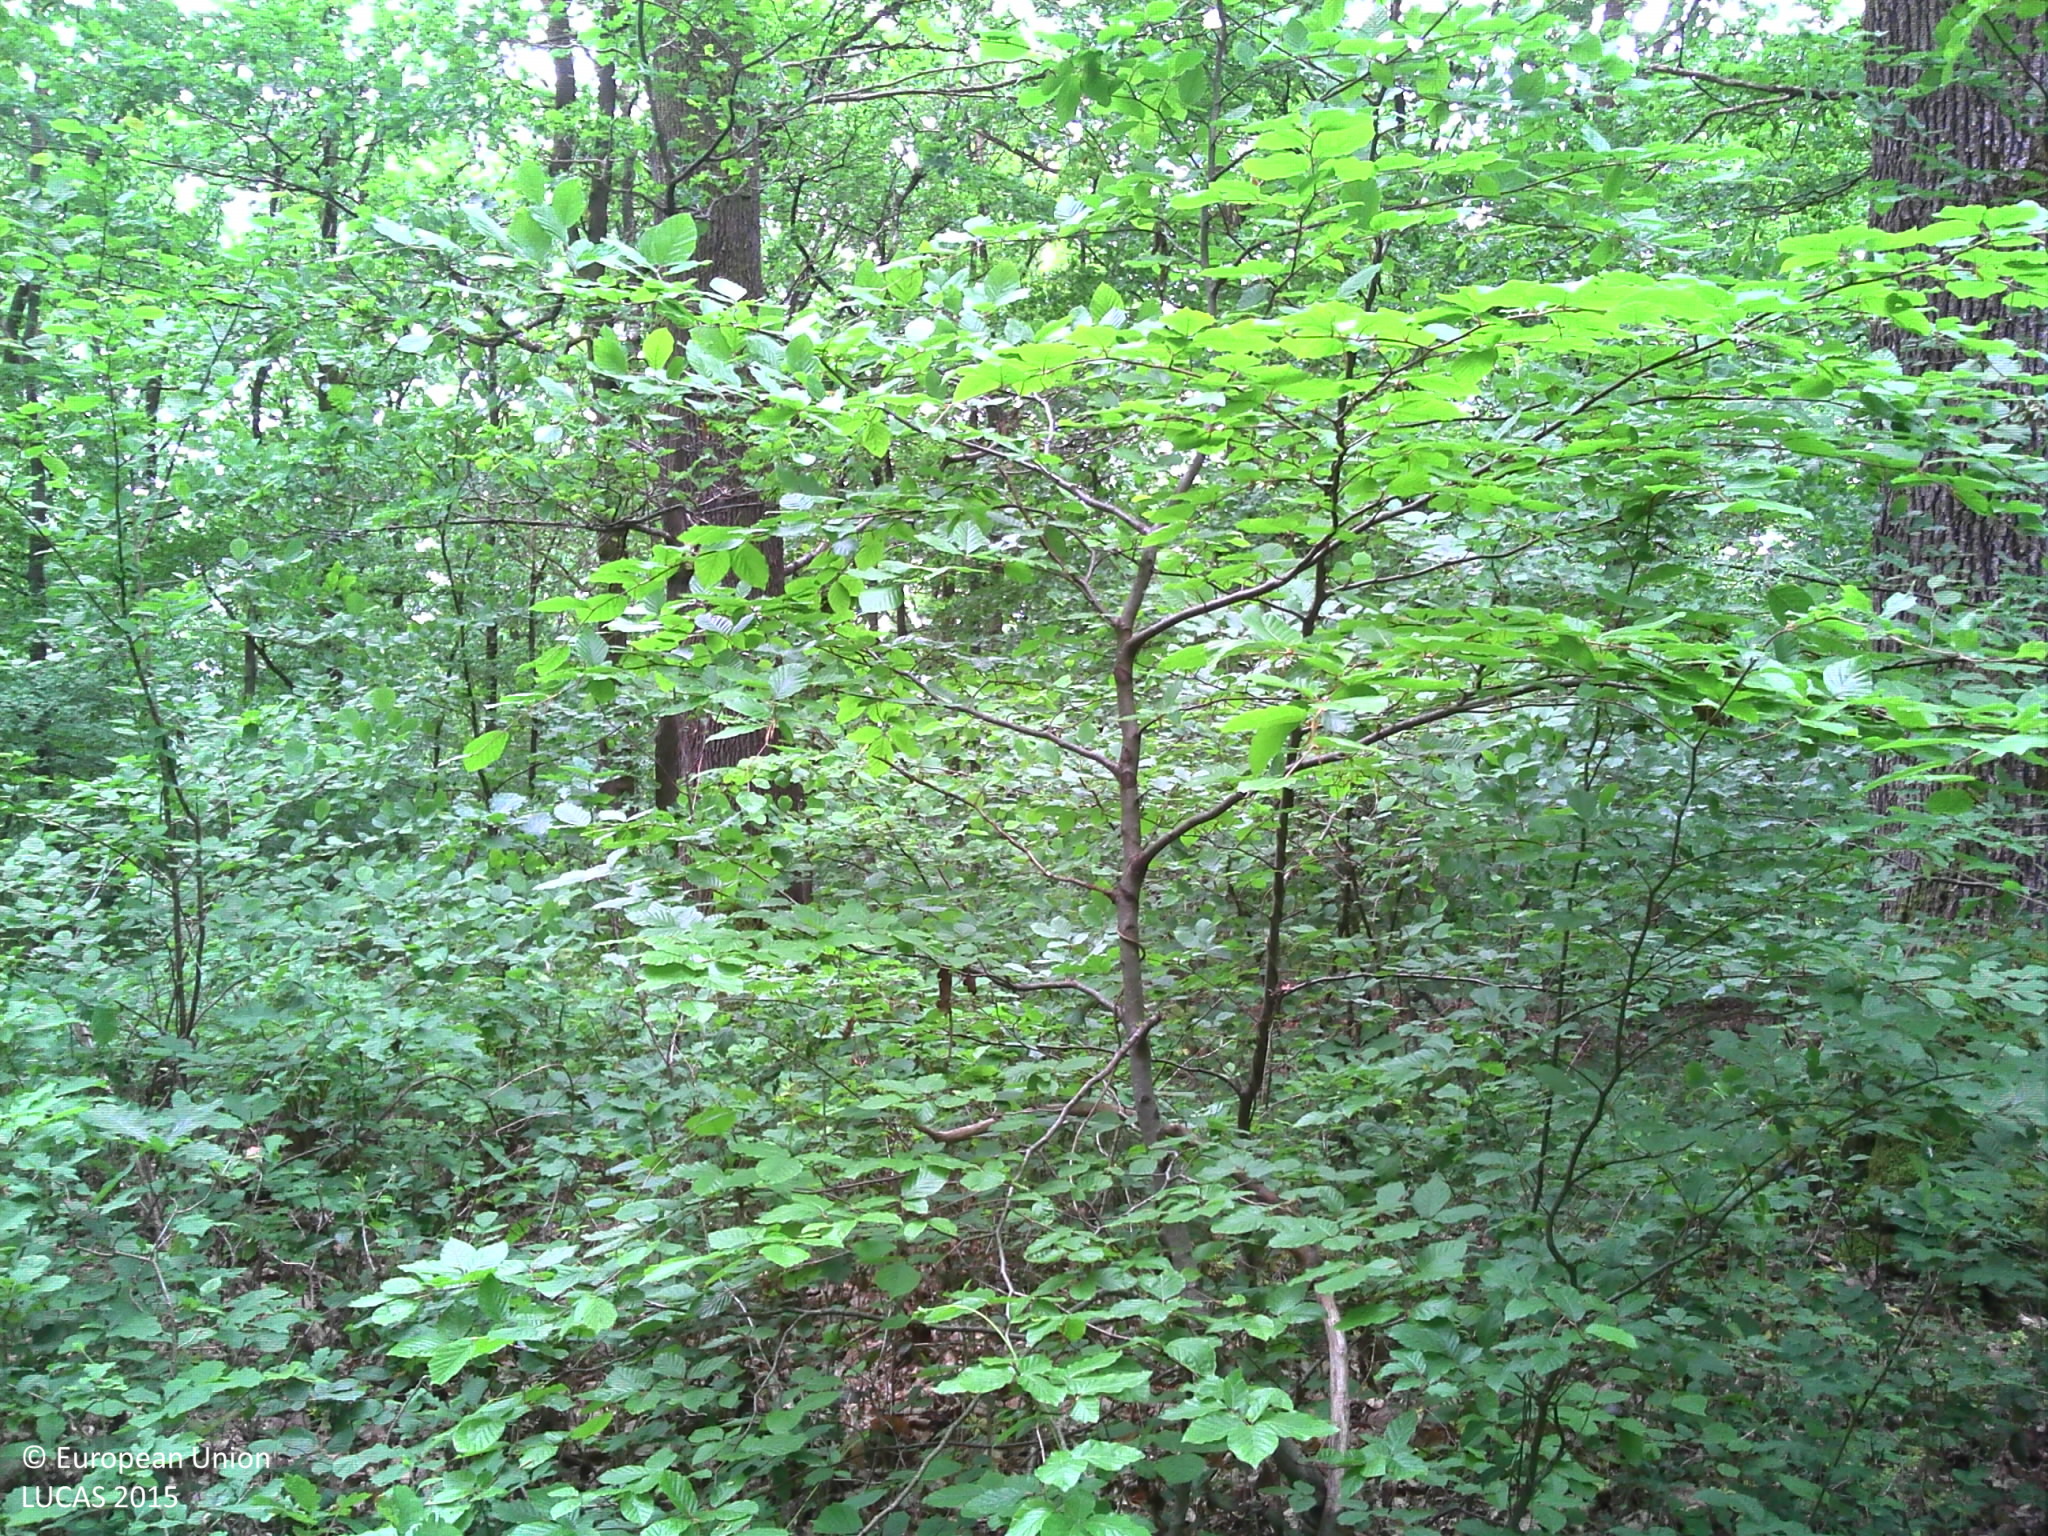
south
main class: Woodland
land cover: Broadleaved woodland
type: acidophilous oak and oak-birch forest
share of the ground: > 75 %
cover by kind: broadleaved forest trees 85 %, herbaceous plants 15 %
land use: Forestry
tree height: > 5 m
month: June
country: BE
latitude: 50.4053
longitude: 5.5944
